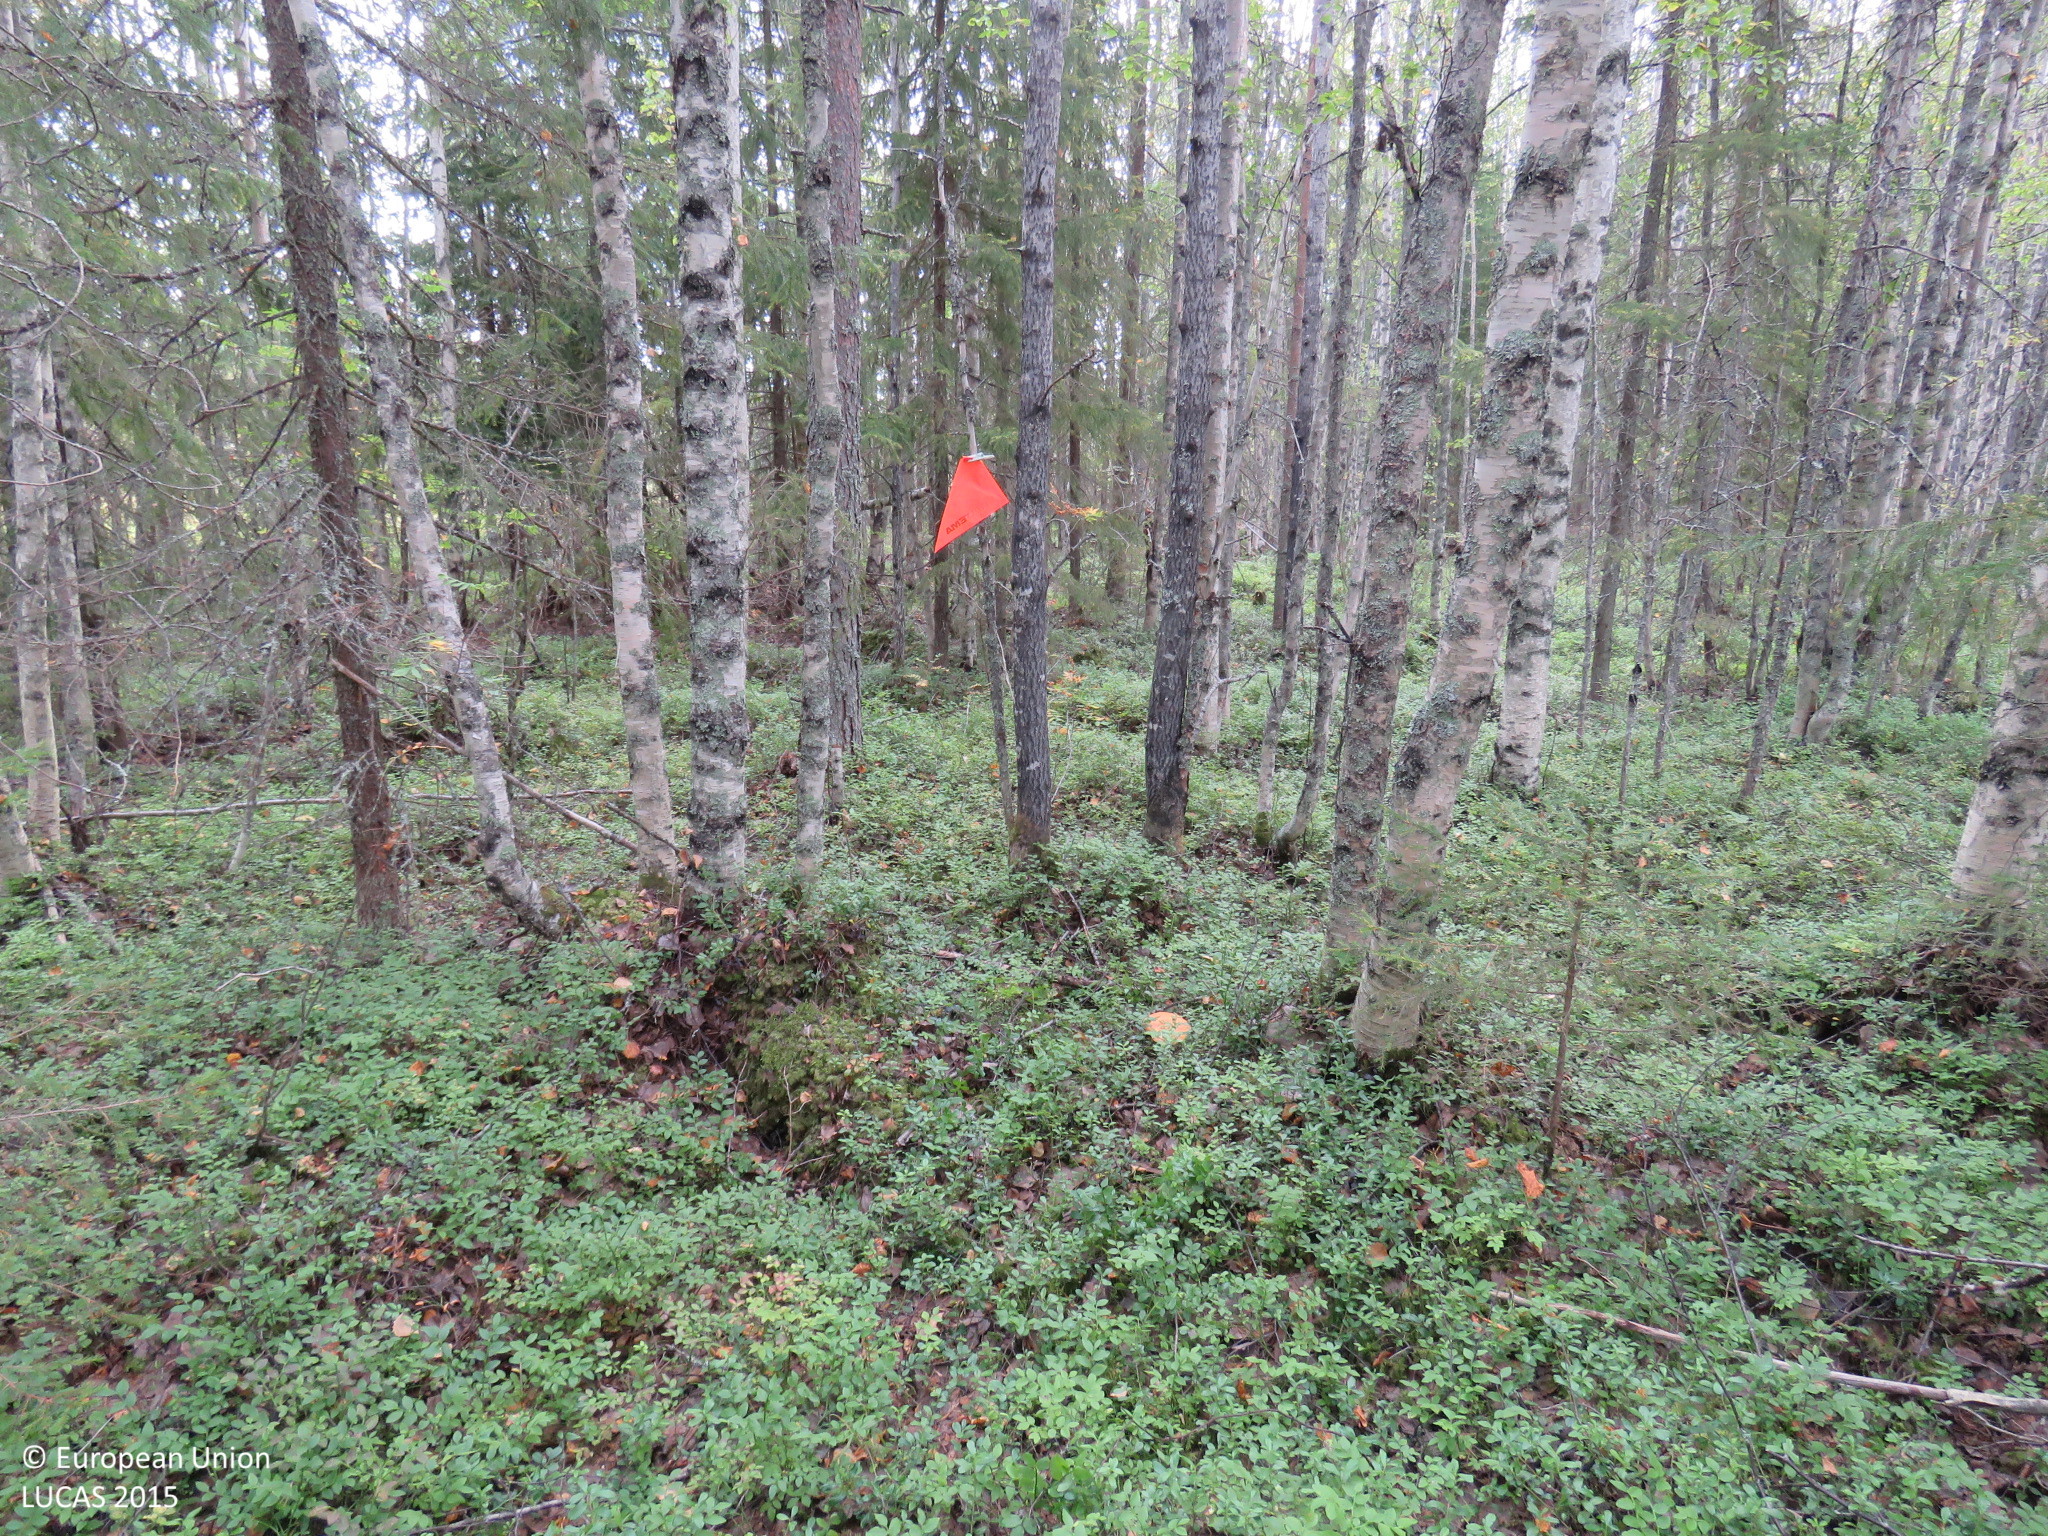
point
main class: Woodland
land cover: Other mixed woodland
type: boreal forest
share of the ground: > 75 %
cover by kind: coniferous forest trees 50 %, broadleaved forest trees 40 %, shrubs 10 %
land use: Forestry
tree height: > 5 m
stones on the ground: < 10 %
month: August
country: FI
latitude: 64.9549
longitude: 26.1255
